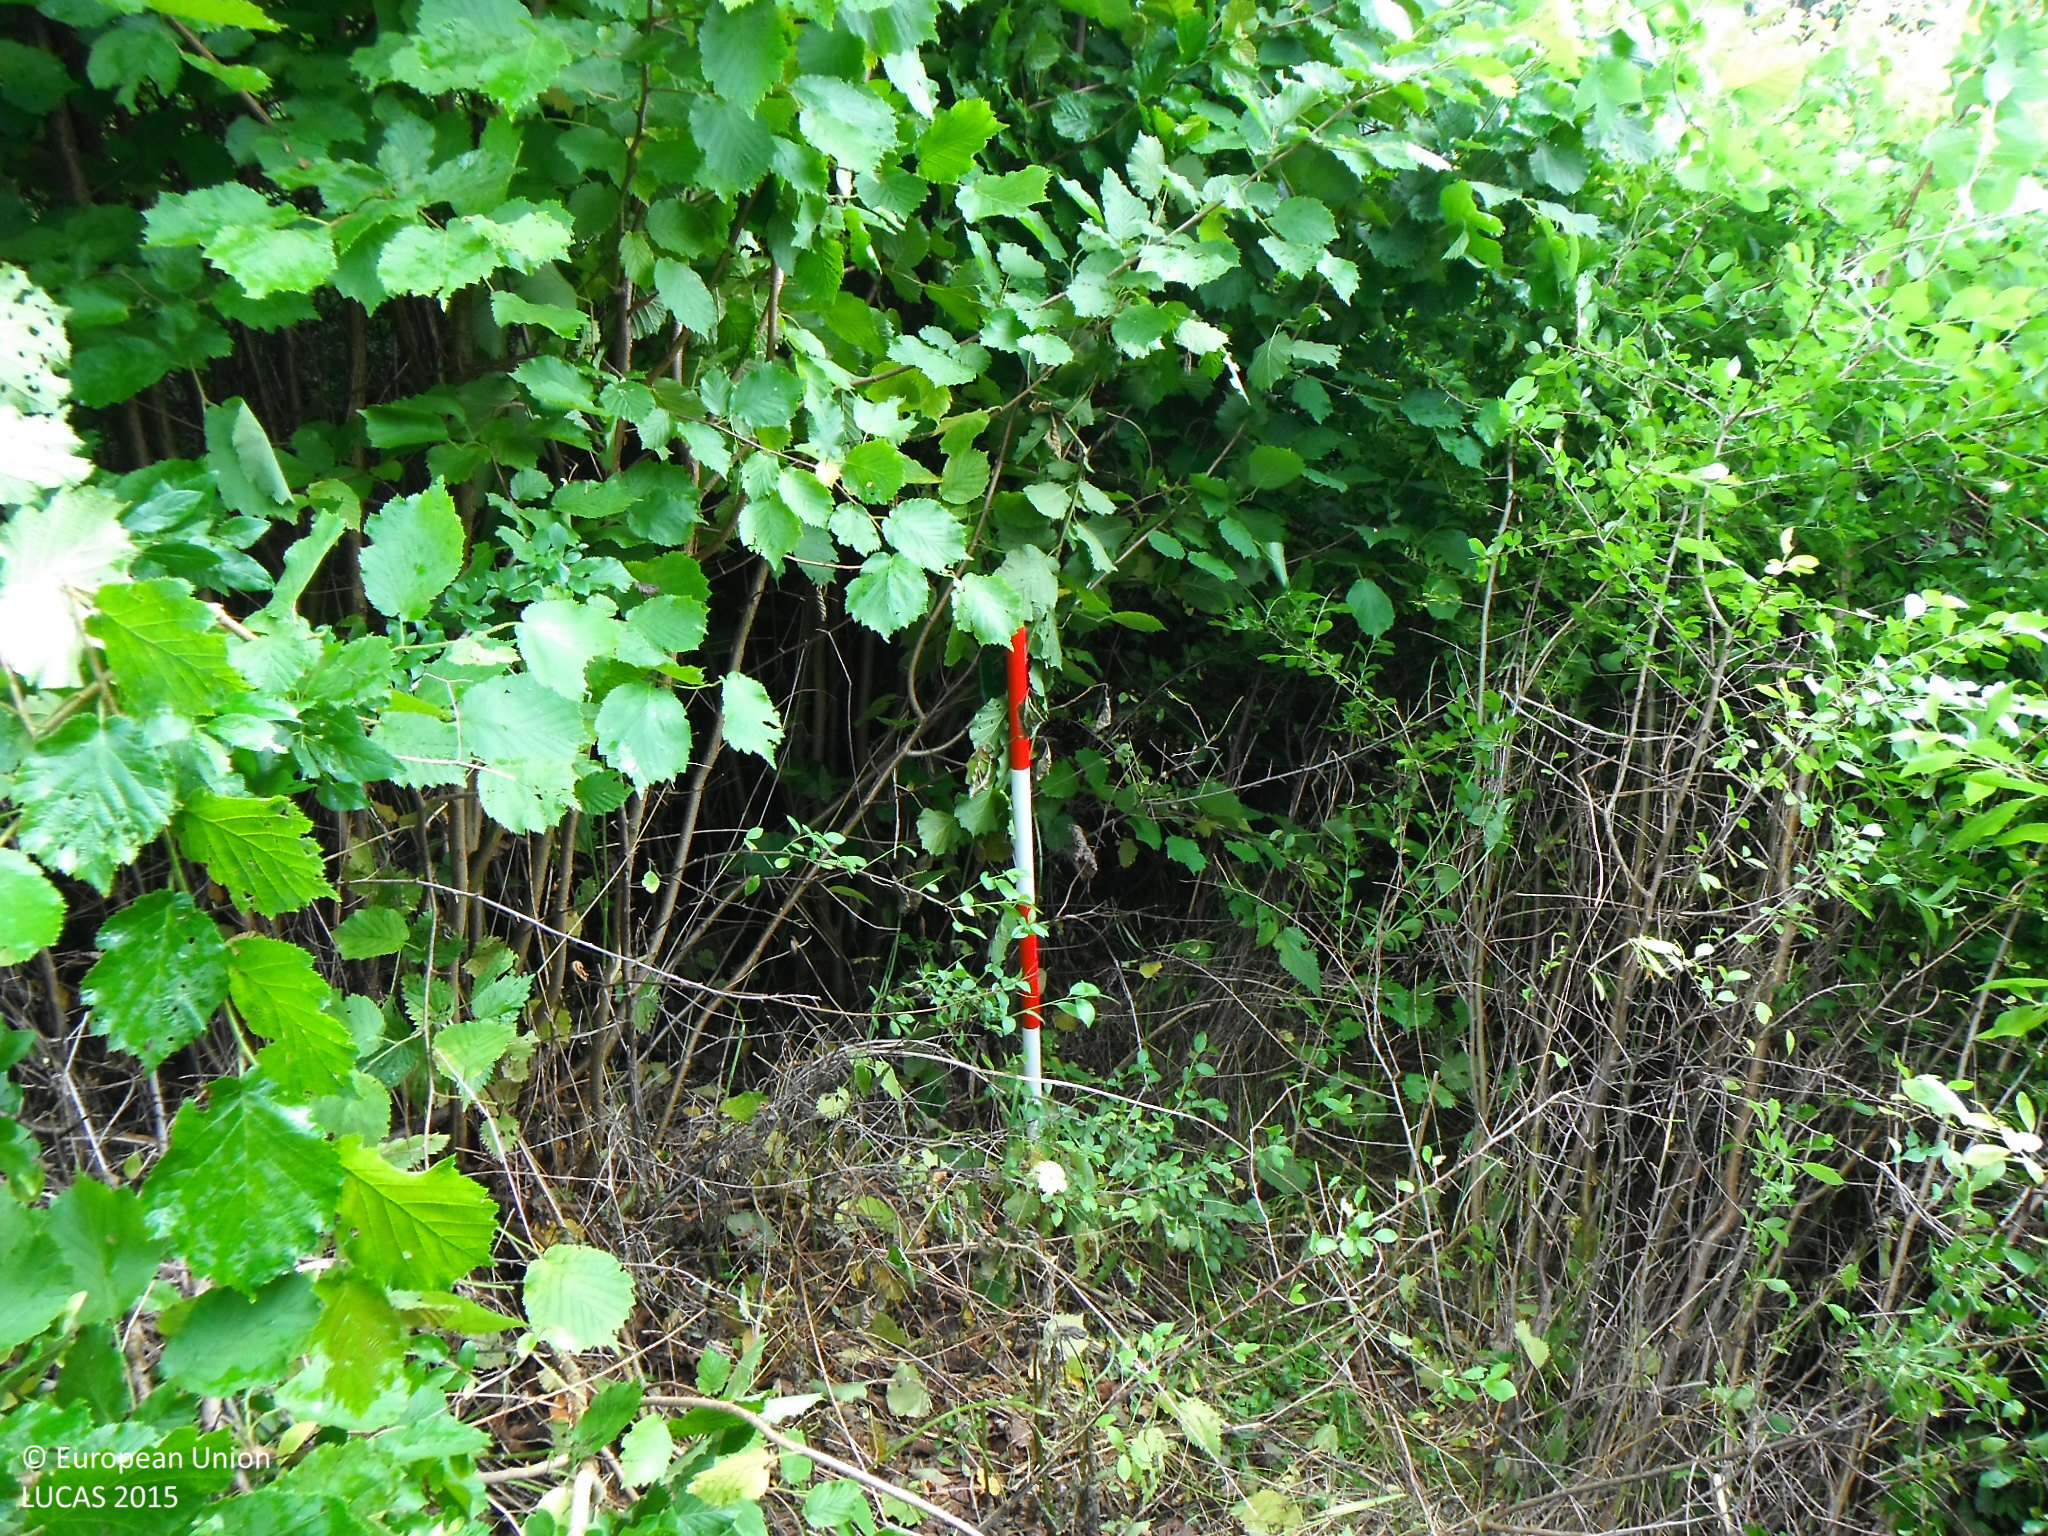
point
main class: Shrubland
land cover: Shrubland with sparse tree cover
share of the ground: > 75 %
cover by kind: shrubs 85 %, herbaceous plants 10 %, broadleaved forest trees 5 %
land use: Abandoned areas
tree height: > 5 m
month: June
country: SK
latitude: 49.2684
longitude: 21.7199
